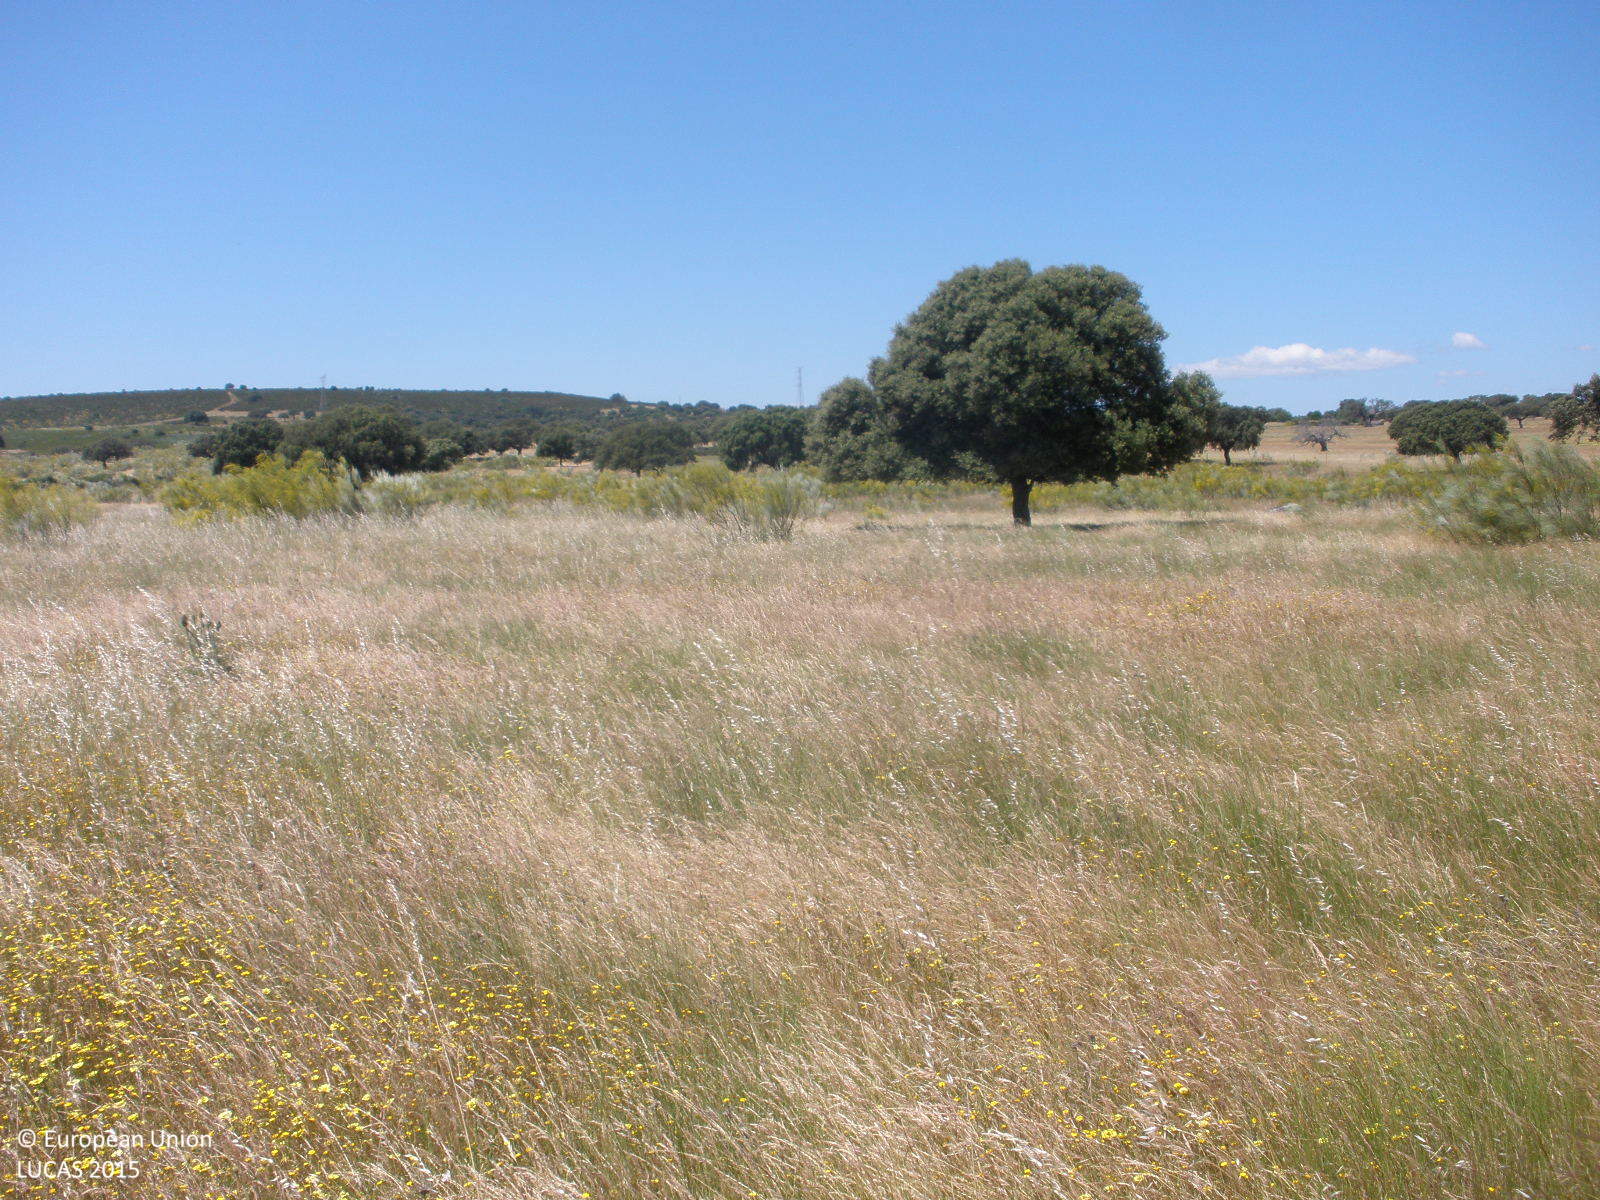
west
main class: Shrubland
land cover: Shrubland without tree cover
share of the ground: > 75 %
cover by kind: herbaceous plants 80 %, shrubs 20 %
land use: Agriculture (excluding fallow land and kitchen gardens)
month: May
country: ES
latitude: 40.1961
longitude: -6.1091
